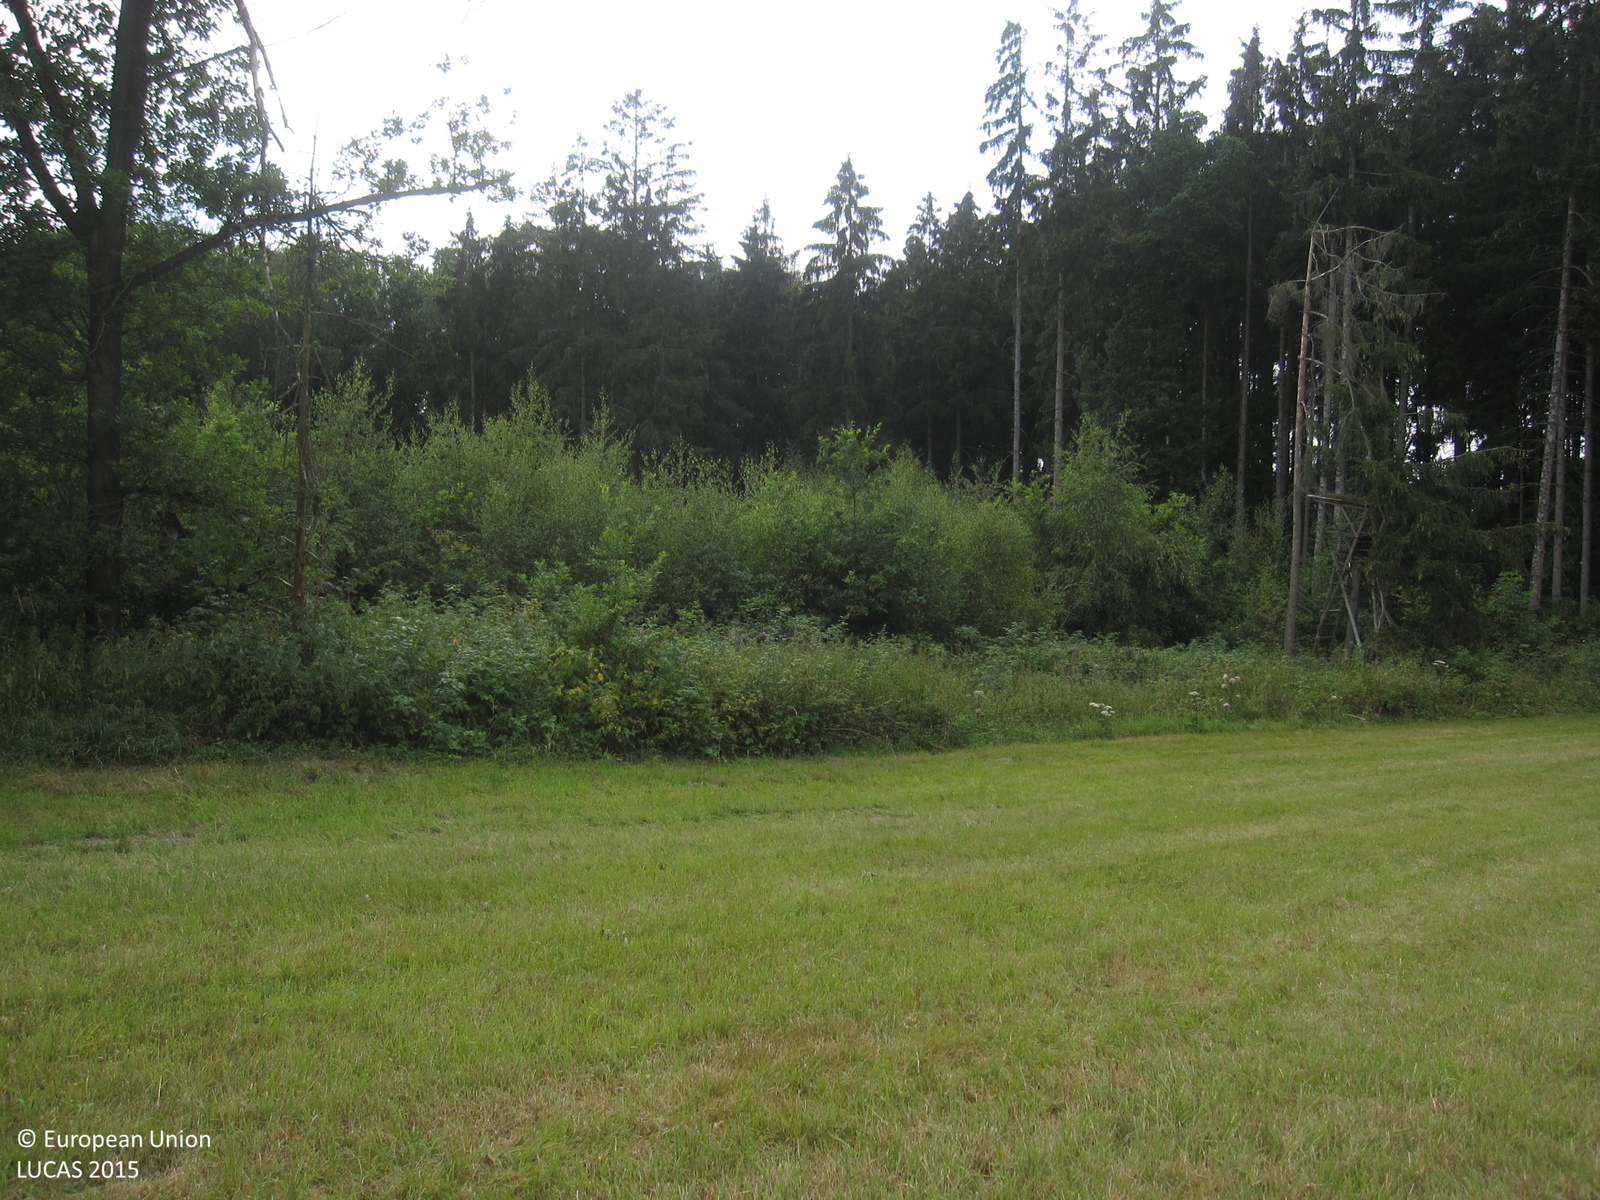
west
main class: Grassland
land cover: Grassland without tree/shrub cover
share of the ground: > 75 %
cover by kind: herbaceous plants 95 %, unconsolidated bare surface 5 %
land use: Agriculture (excluding fallow land and kitchen gardens)
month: August
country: DE
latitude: 50.5426
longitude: 12.1022
